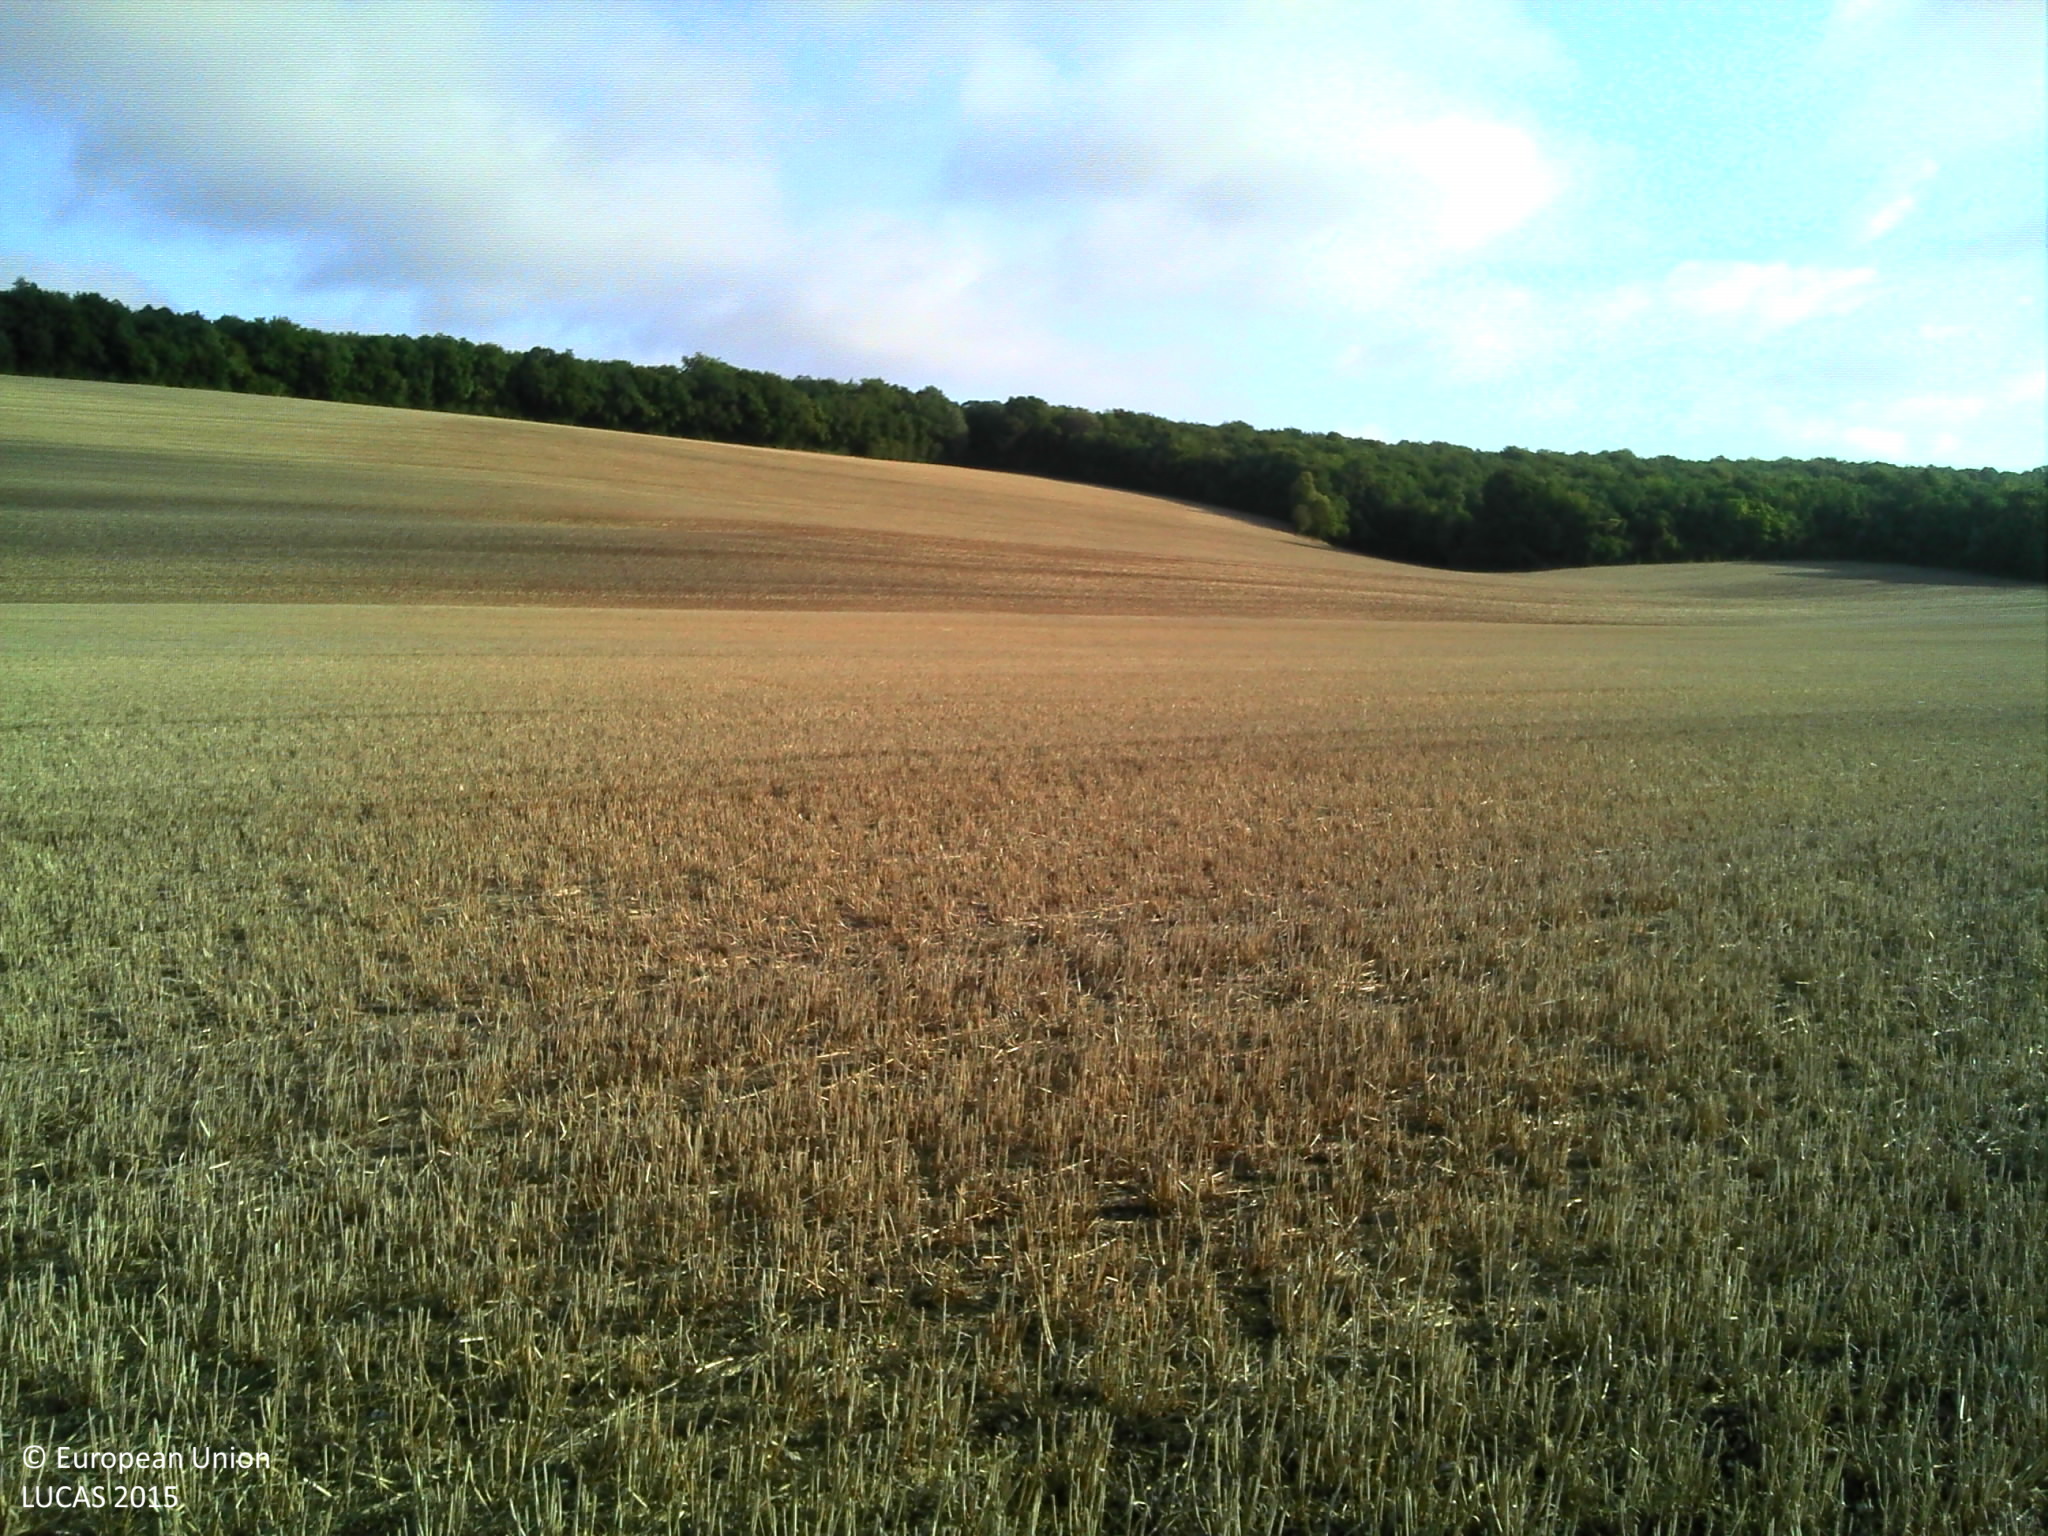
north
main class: Cropland
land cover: Common wheat
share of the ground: > 75 %
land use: Agriculture (excluding fallow land and kitchen gardens)
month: August
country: FR
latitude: 47.8613
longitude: 4.6921
